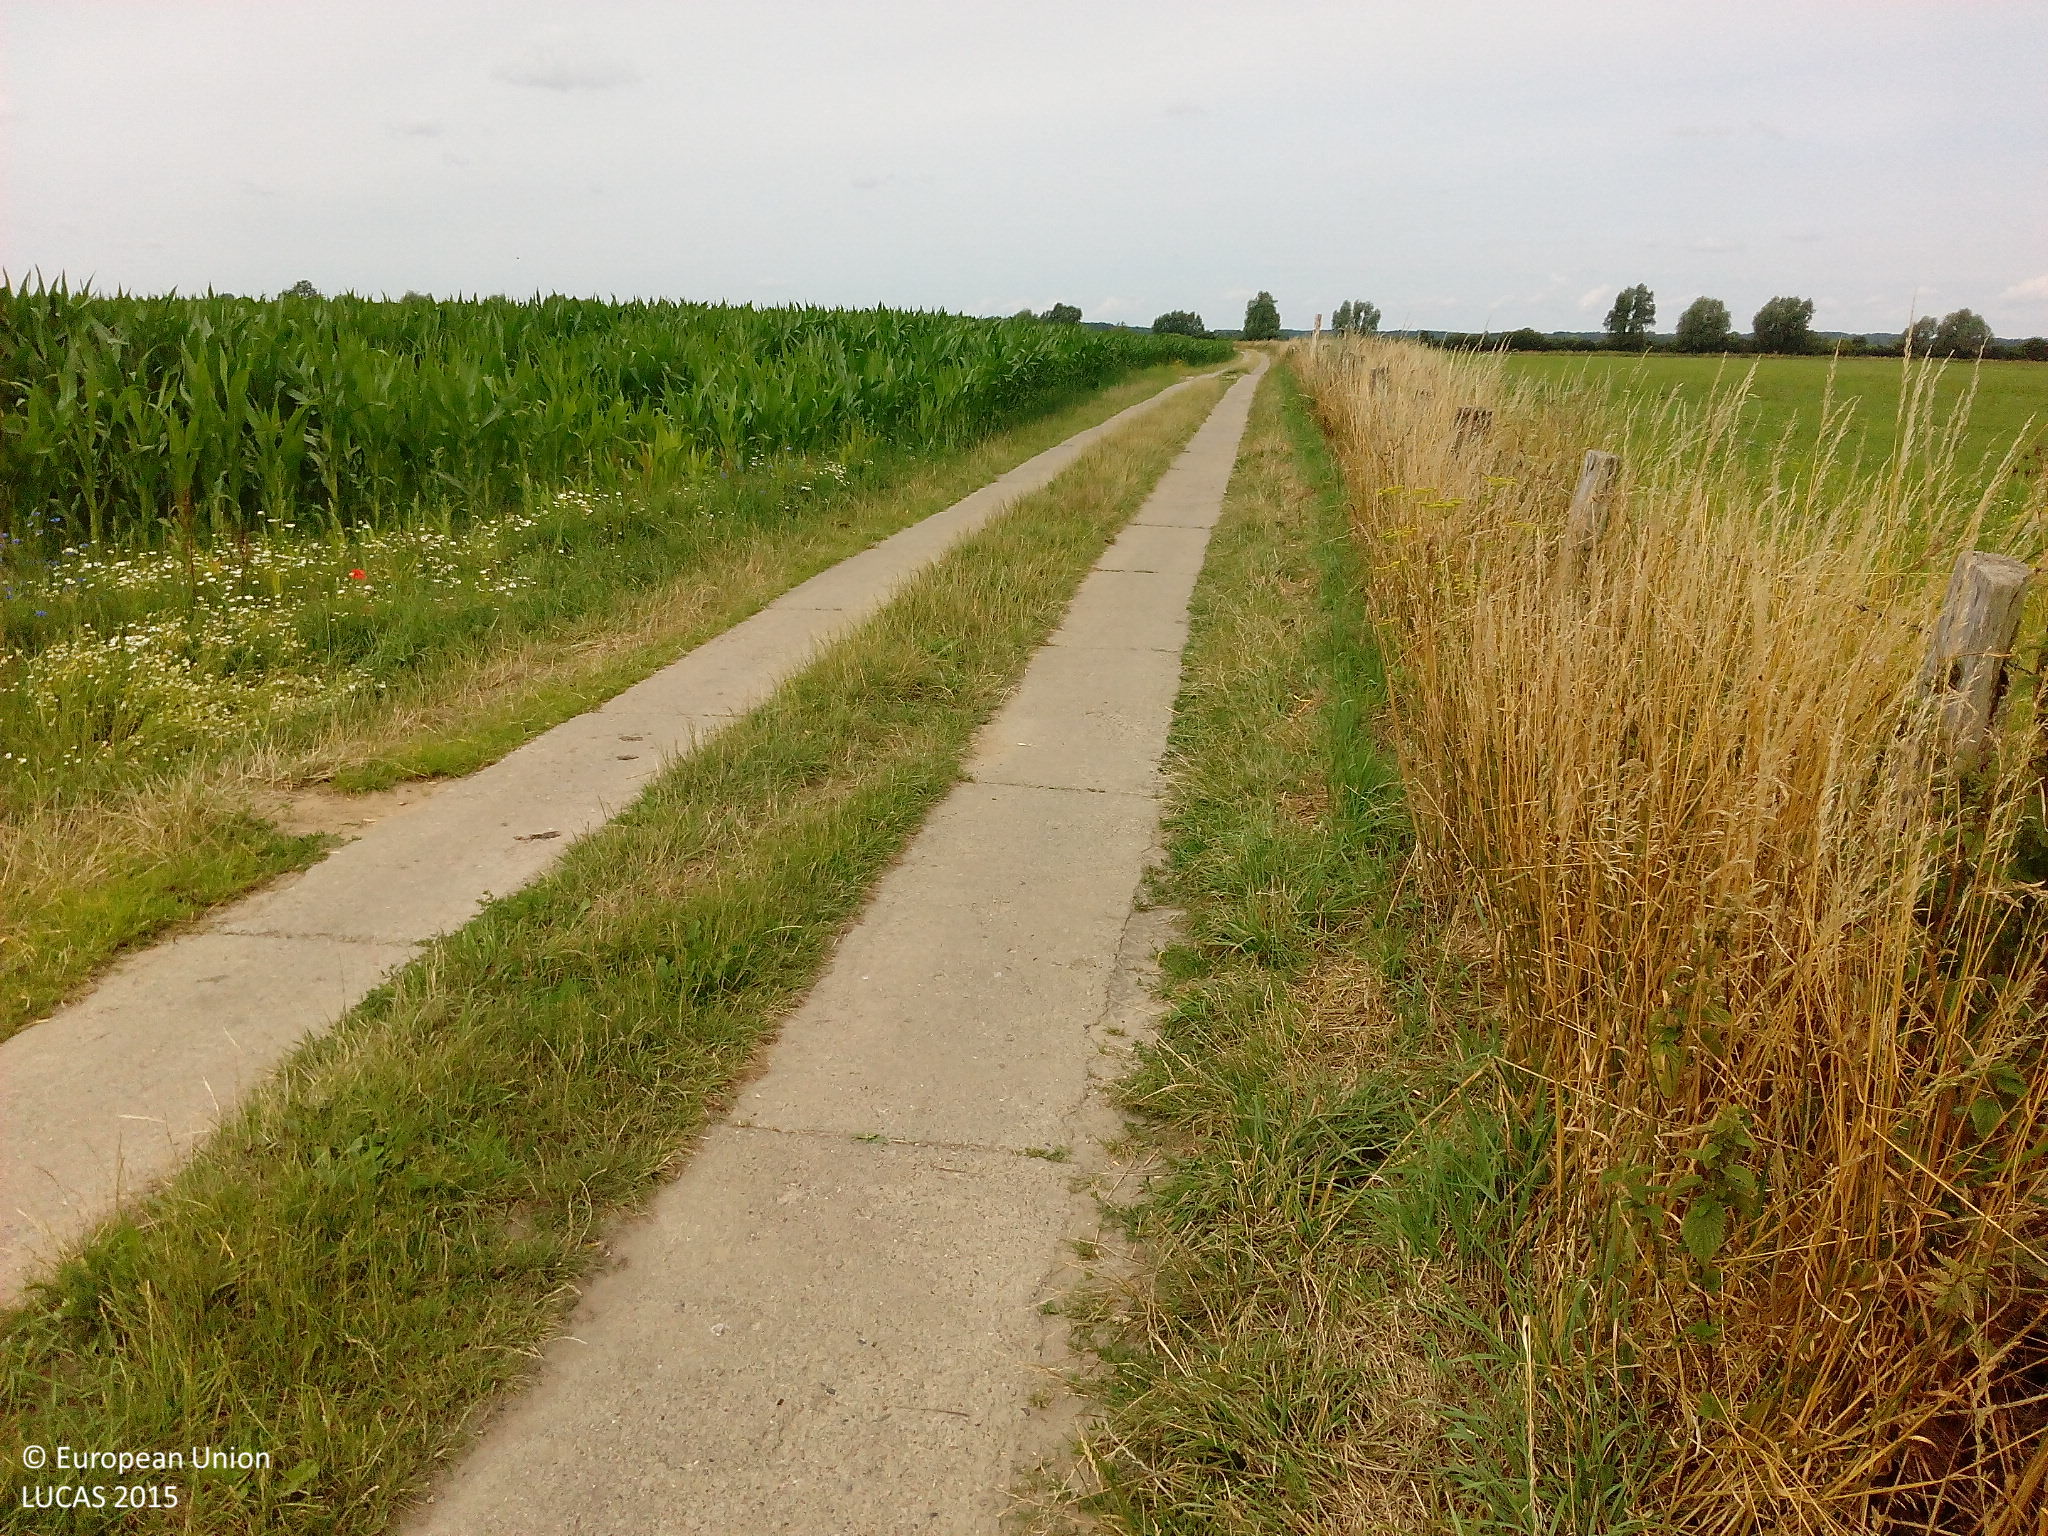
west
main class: Grassland
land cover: Grassland without tree/shrub cover
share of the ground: > 75 %
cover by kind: herbaceous plants 100 %
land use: Agriculture (excluding fallow land and kitchen gardens)
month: July
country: DE
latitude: 54.0949
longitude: 13.2868
